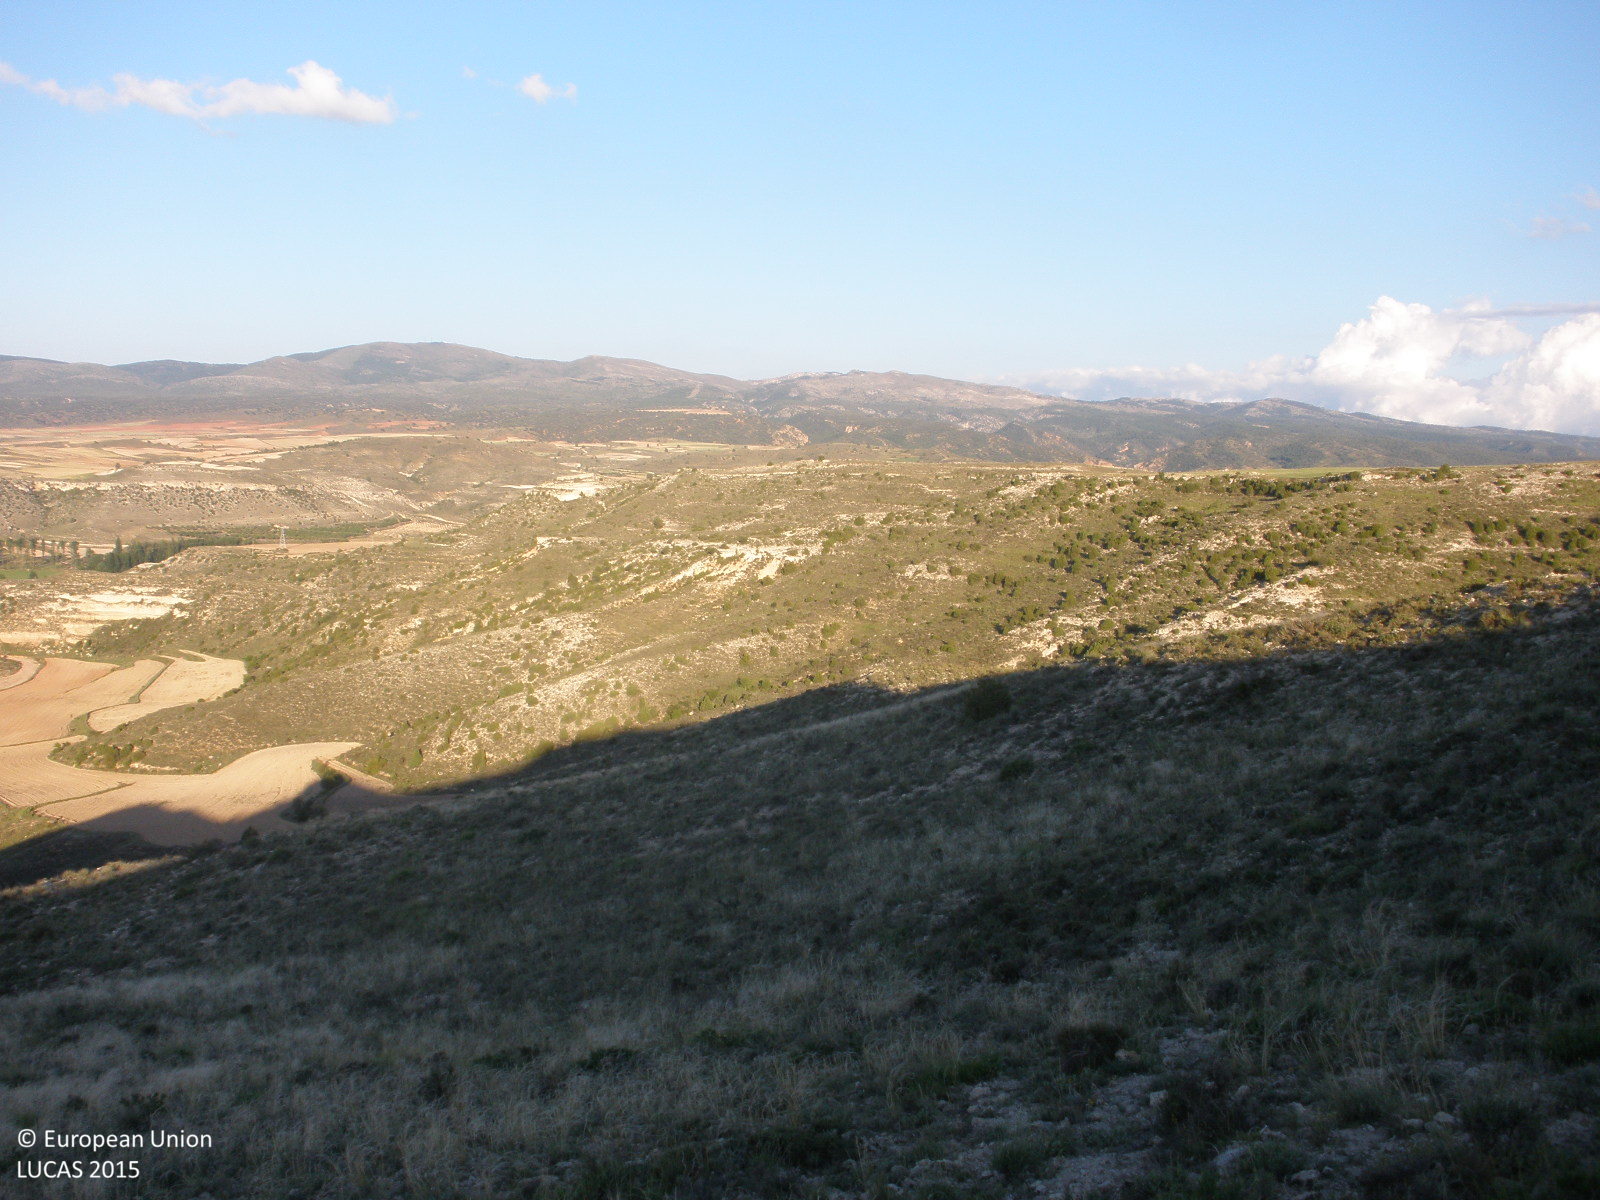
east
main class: Shrubland
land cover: Shrubland without tree cover
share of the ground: 25 - 50 %
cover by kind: shrubs 40 %, herbaceous plants 30 %, consolidated bare surface 30 %
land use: Agriculture (excluding fallow land and kitchen gardens)
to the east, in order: Shrubland without tree cover
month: June
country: ES
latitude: 40.4991
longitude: -1.0444
